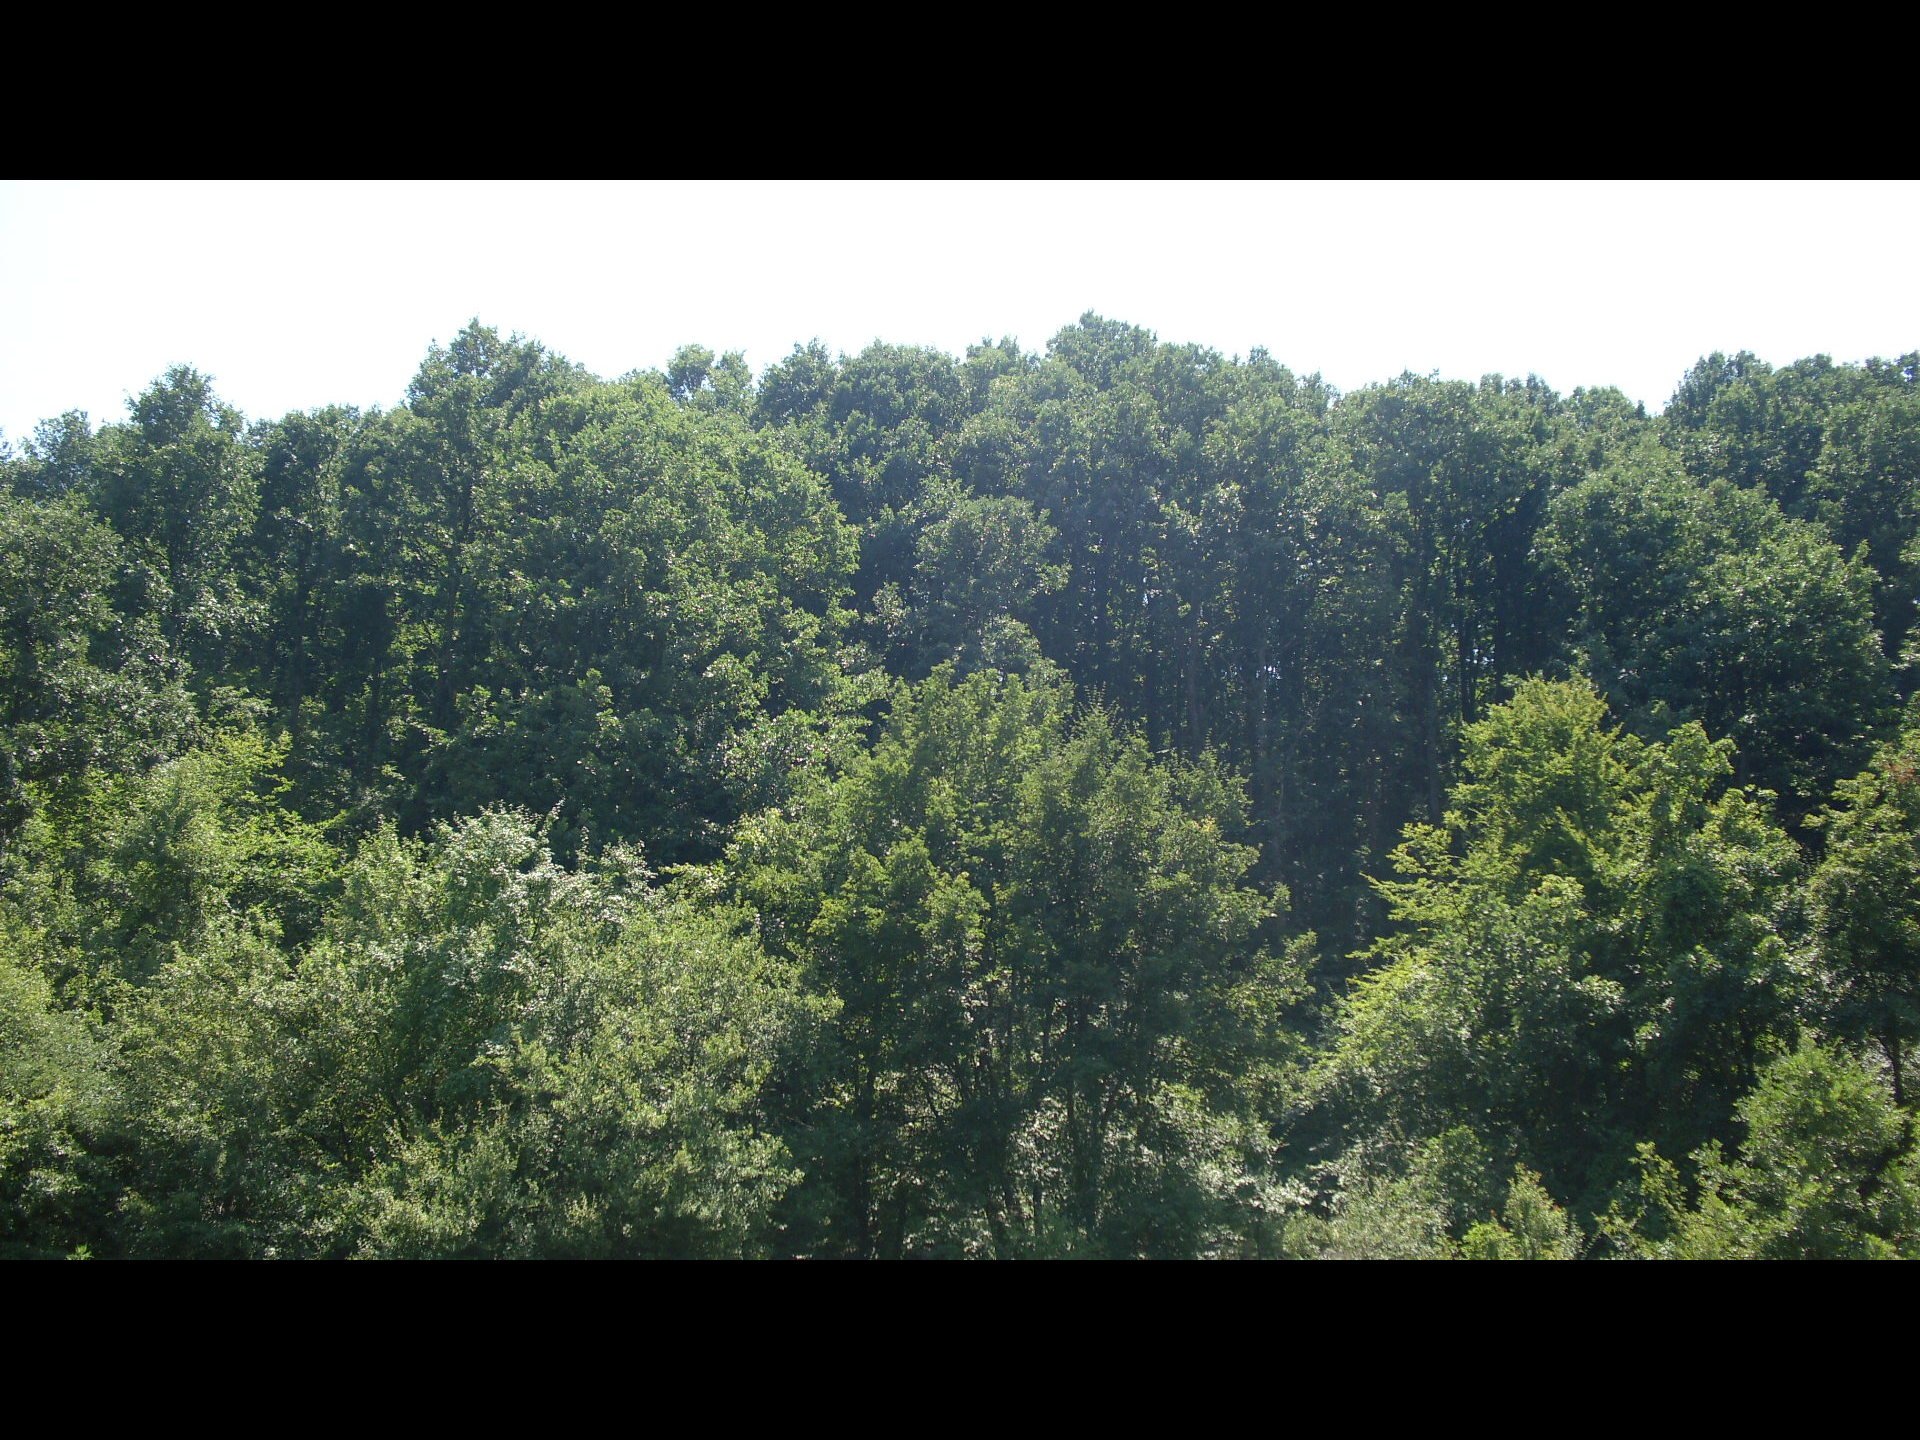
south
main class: Grassland
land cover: Grassland without tree/shrub cover
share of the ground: > 75 %
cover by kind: herbaceous plants 95 %, shrubs 5 %
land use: Abandoned areas
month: July
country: BG
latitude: 43.7296
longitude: 22.7104
